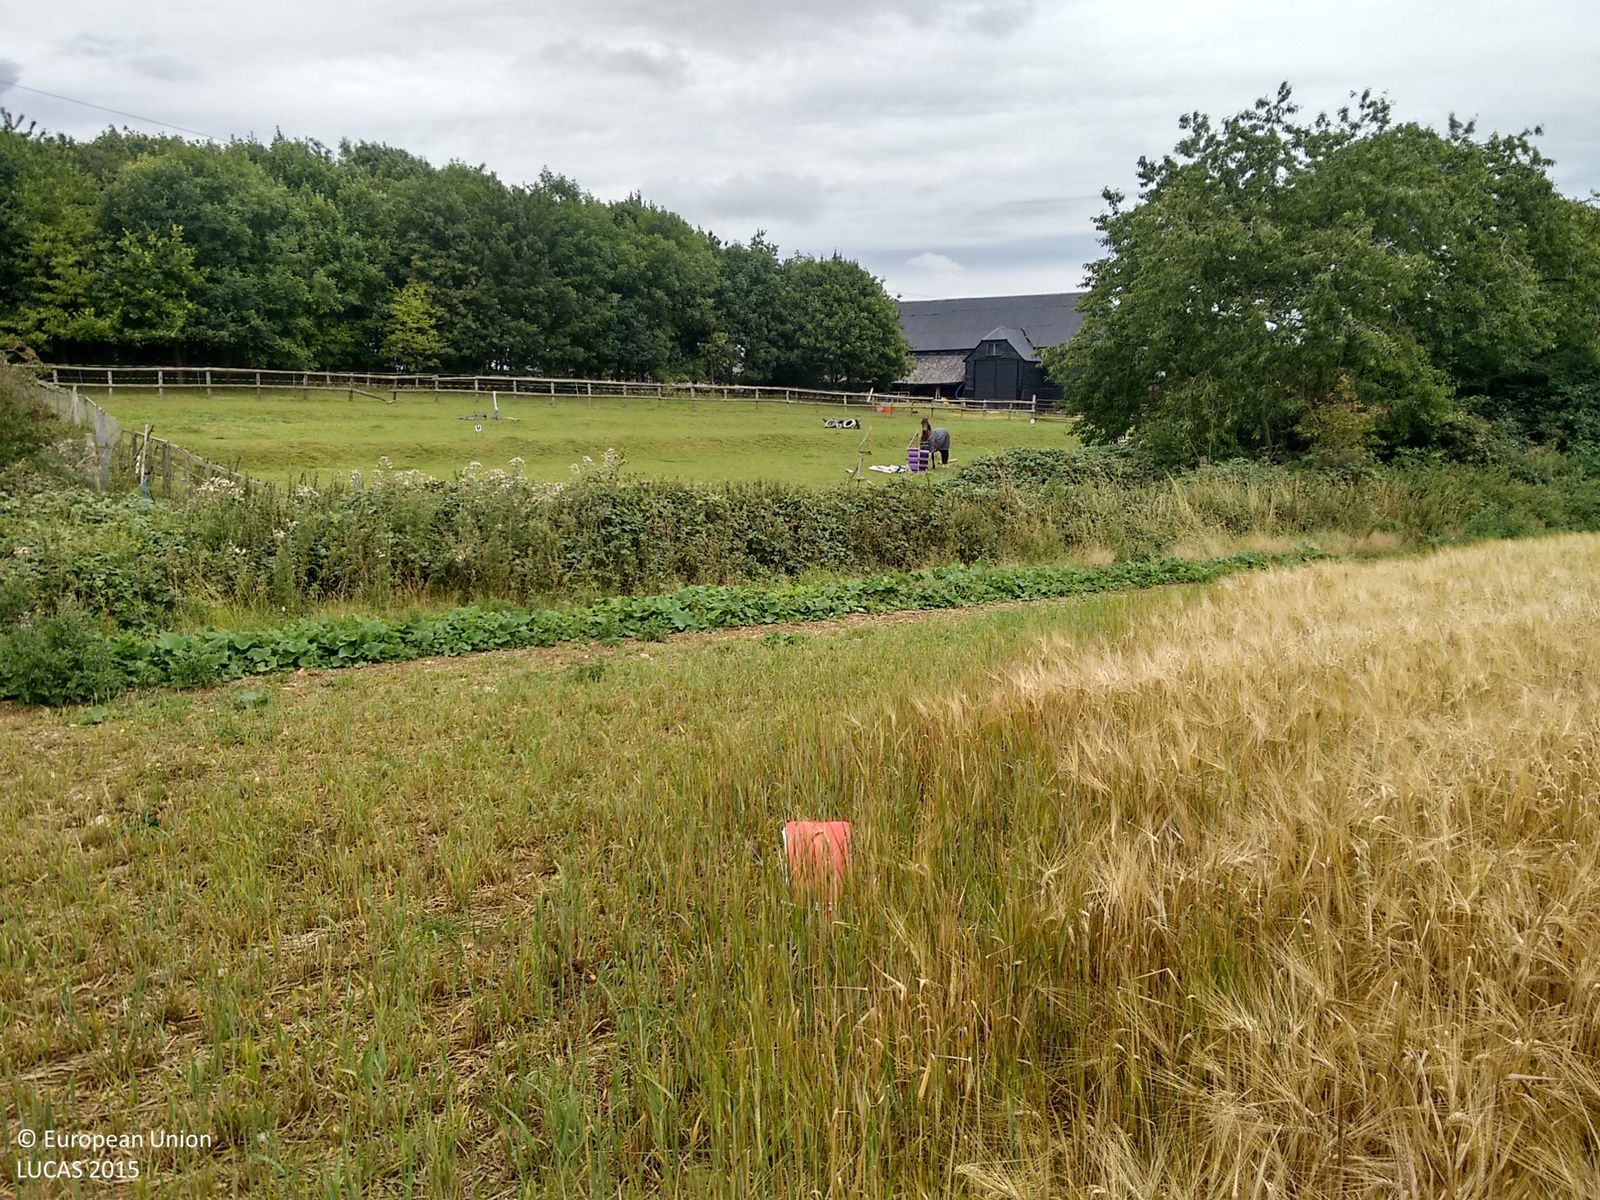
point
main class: Cropland
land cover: Barley
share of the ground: > 75 %
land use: Agriculture (excluding fallow land and kitchen gardens)
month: August
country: GB
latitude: 52.0530
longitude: 0.5373
